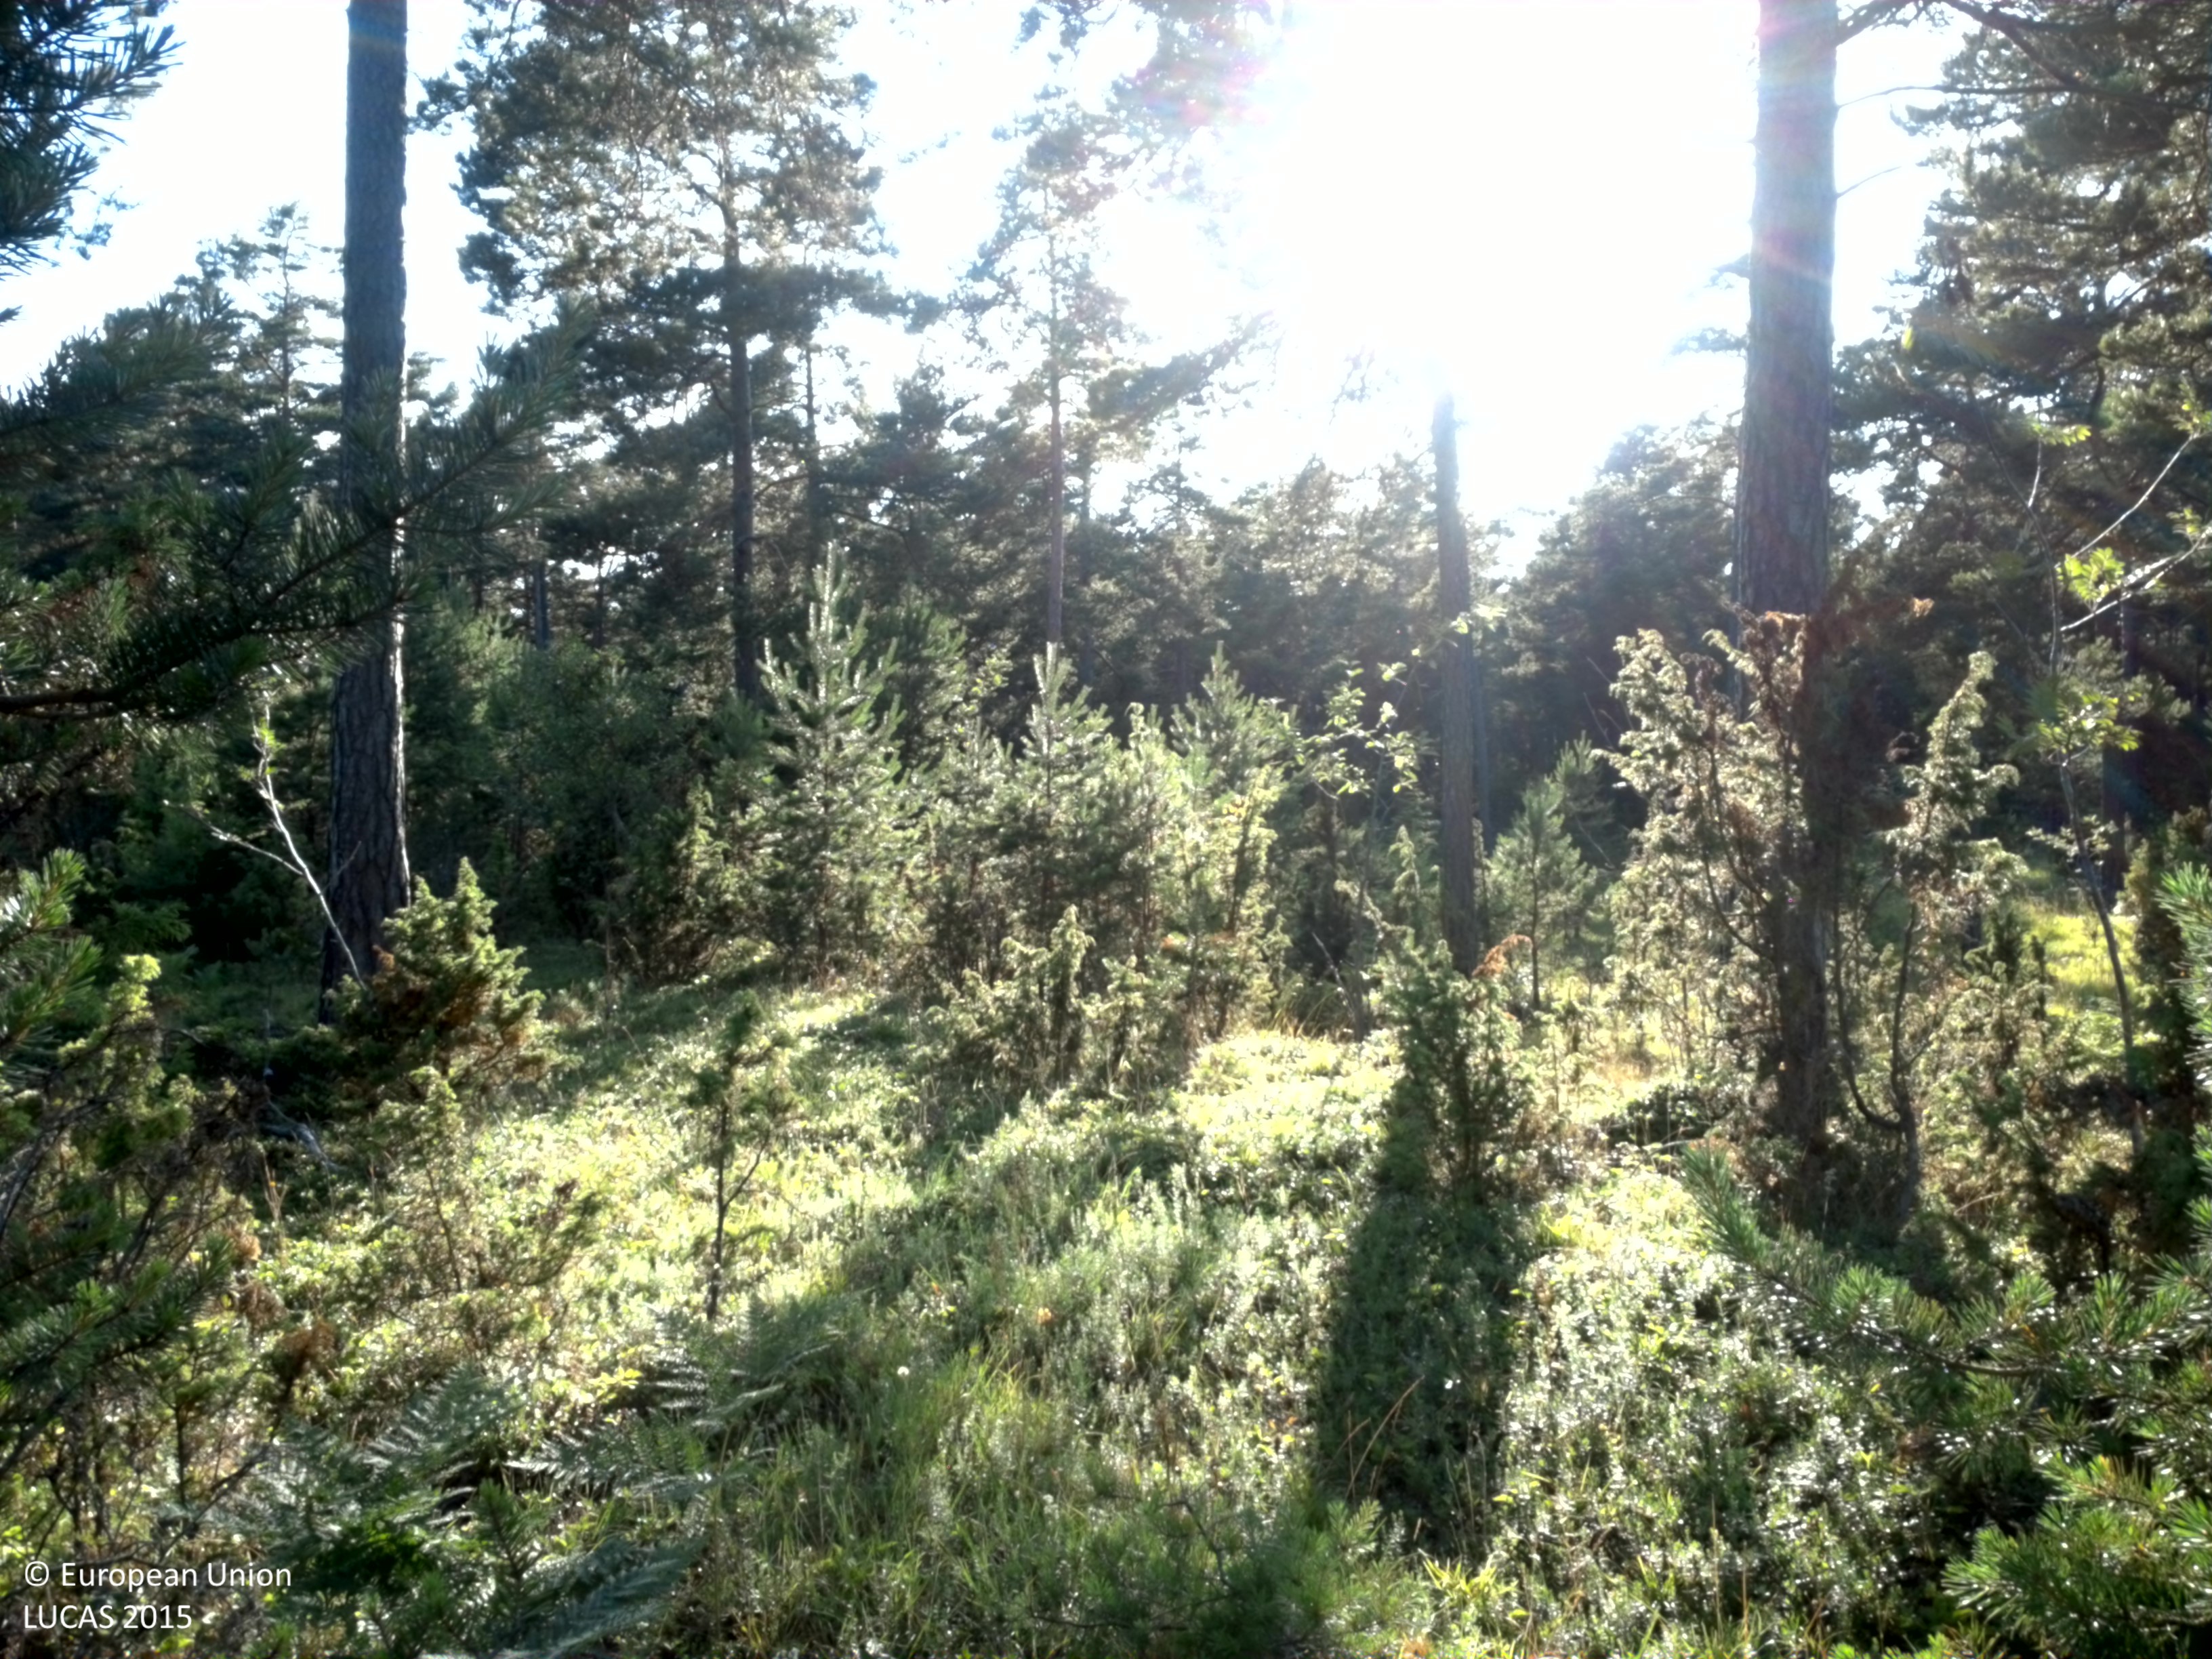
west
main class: Woodland
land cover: Pine dominated coniferous woodland
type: hemiboreal forest and nemoral coniferous forest and mixed broadleaved-coniferous forest
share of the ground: 50 - 75 %
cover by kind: coniferous forest trees 65 %, herbaceous plants 20 %, shrubs 15 %
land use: Forestry
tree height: > 5 m
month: July
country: SE
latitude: 57.6049
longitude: 18.7963
